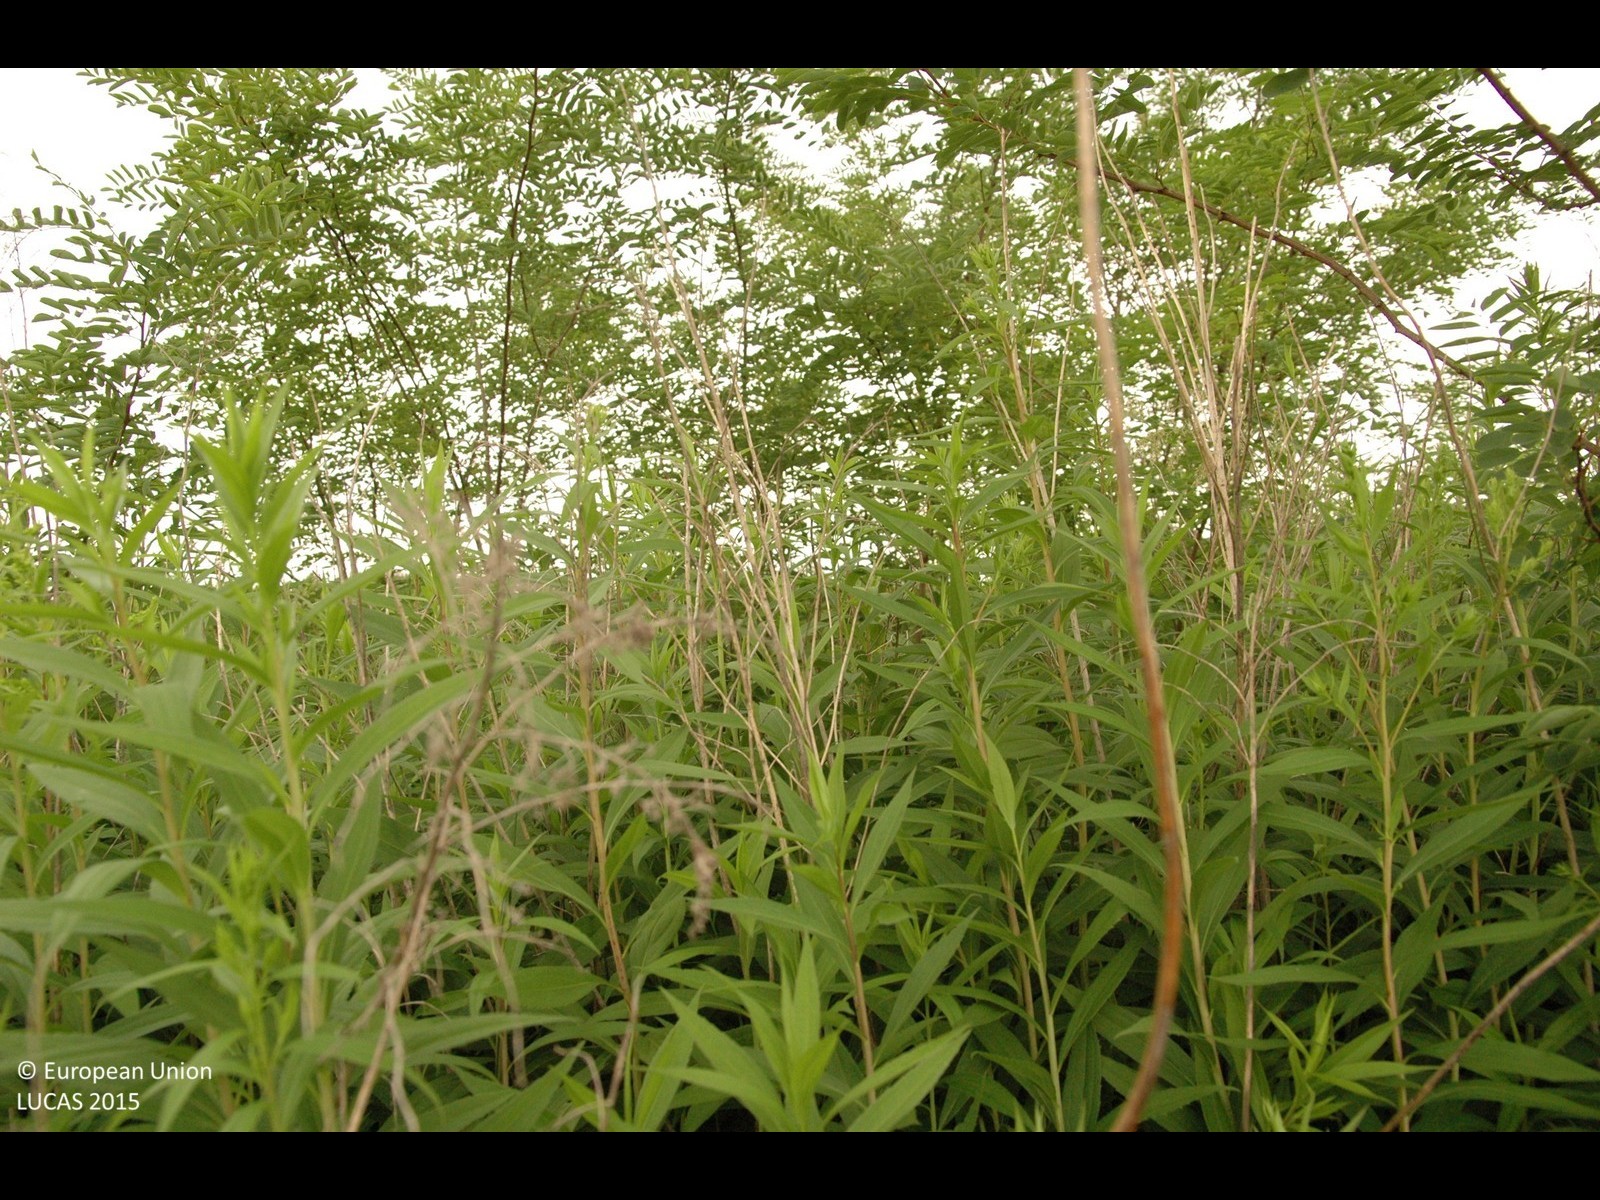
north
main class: Grassland
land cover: Spontaneously vegetated surfaces
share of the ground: > 75 %
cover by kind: herbaceous plants 95 %, shrubs 5 %
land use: Agriculture (excluding fallow land and kitchen gardens)
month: June
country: HR
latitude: 46.4162
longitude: 16.3364
